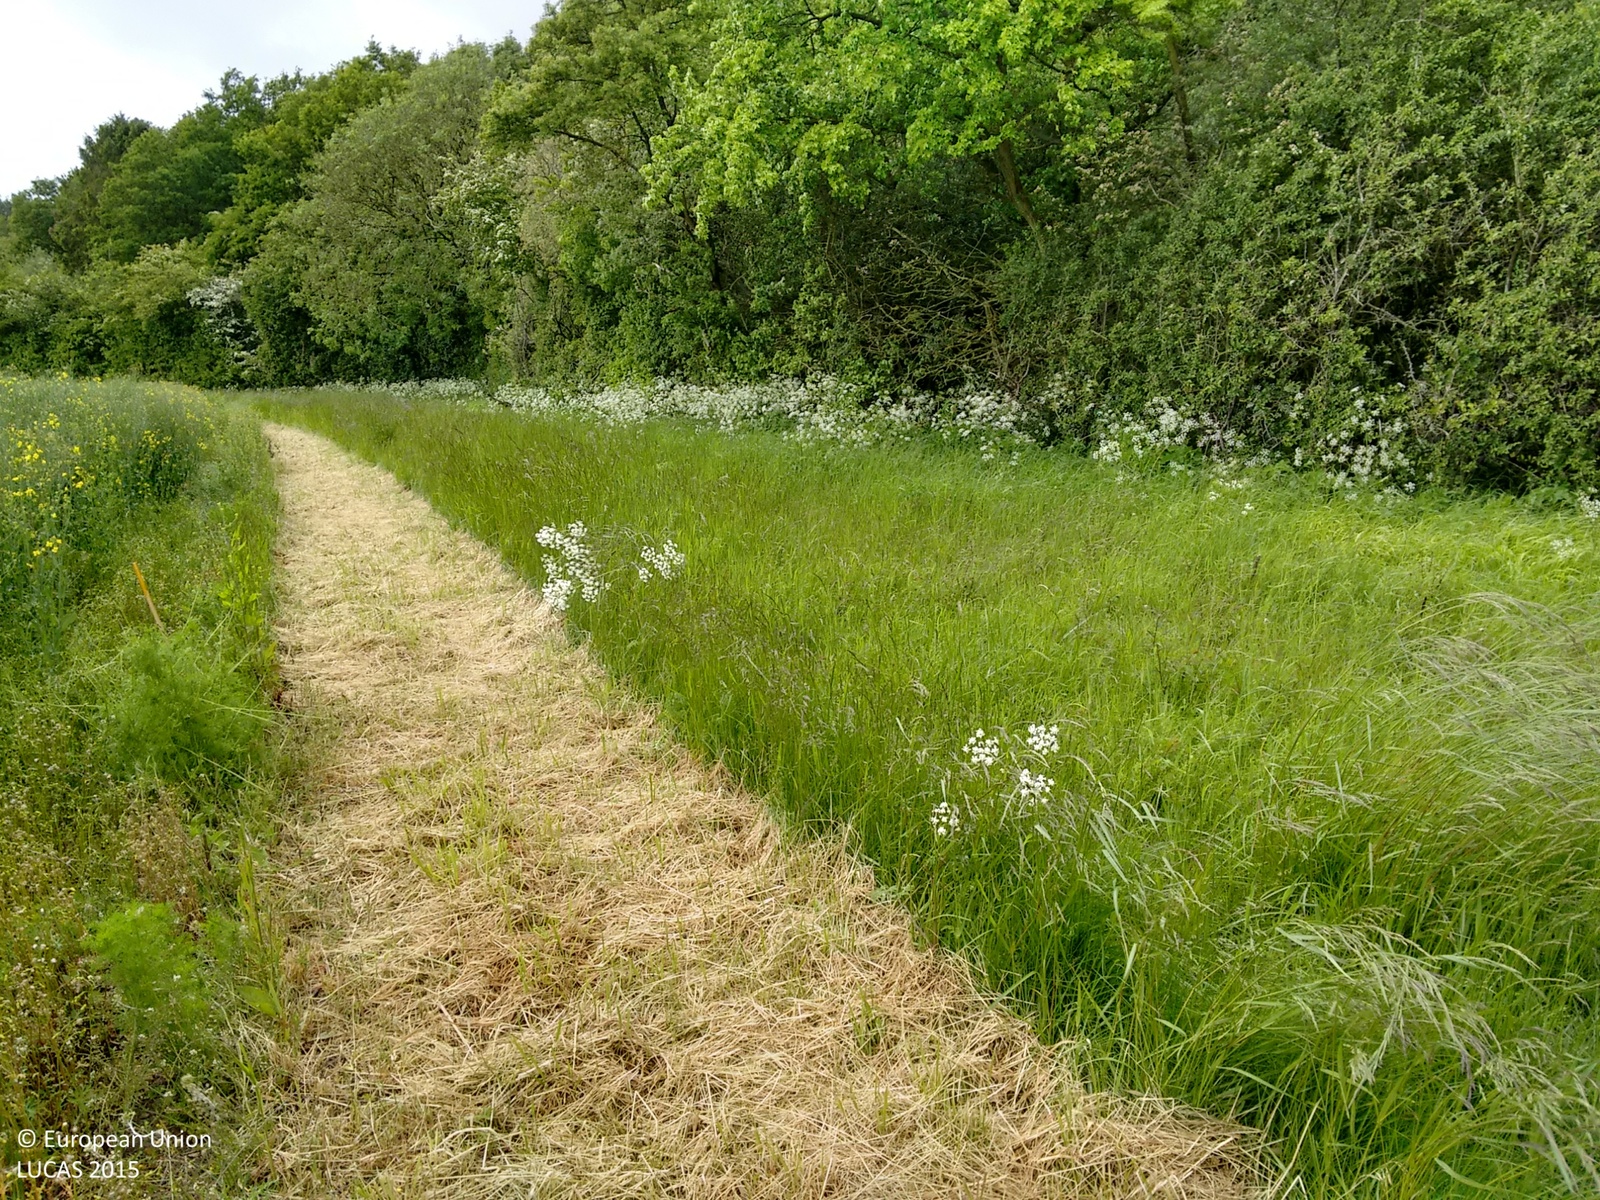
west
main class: Cropland
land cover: Rape and turnip rape
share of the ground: > 75 %
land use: Agriculture (excluding fallow land and kitchen gardens)
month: June
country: GB
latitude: 53.2768
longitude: -0.2171
